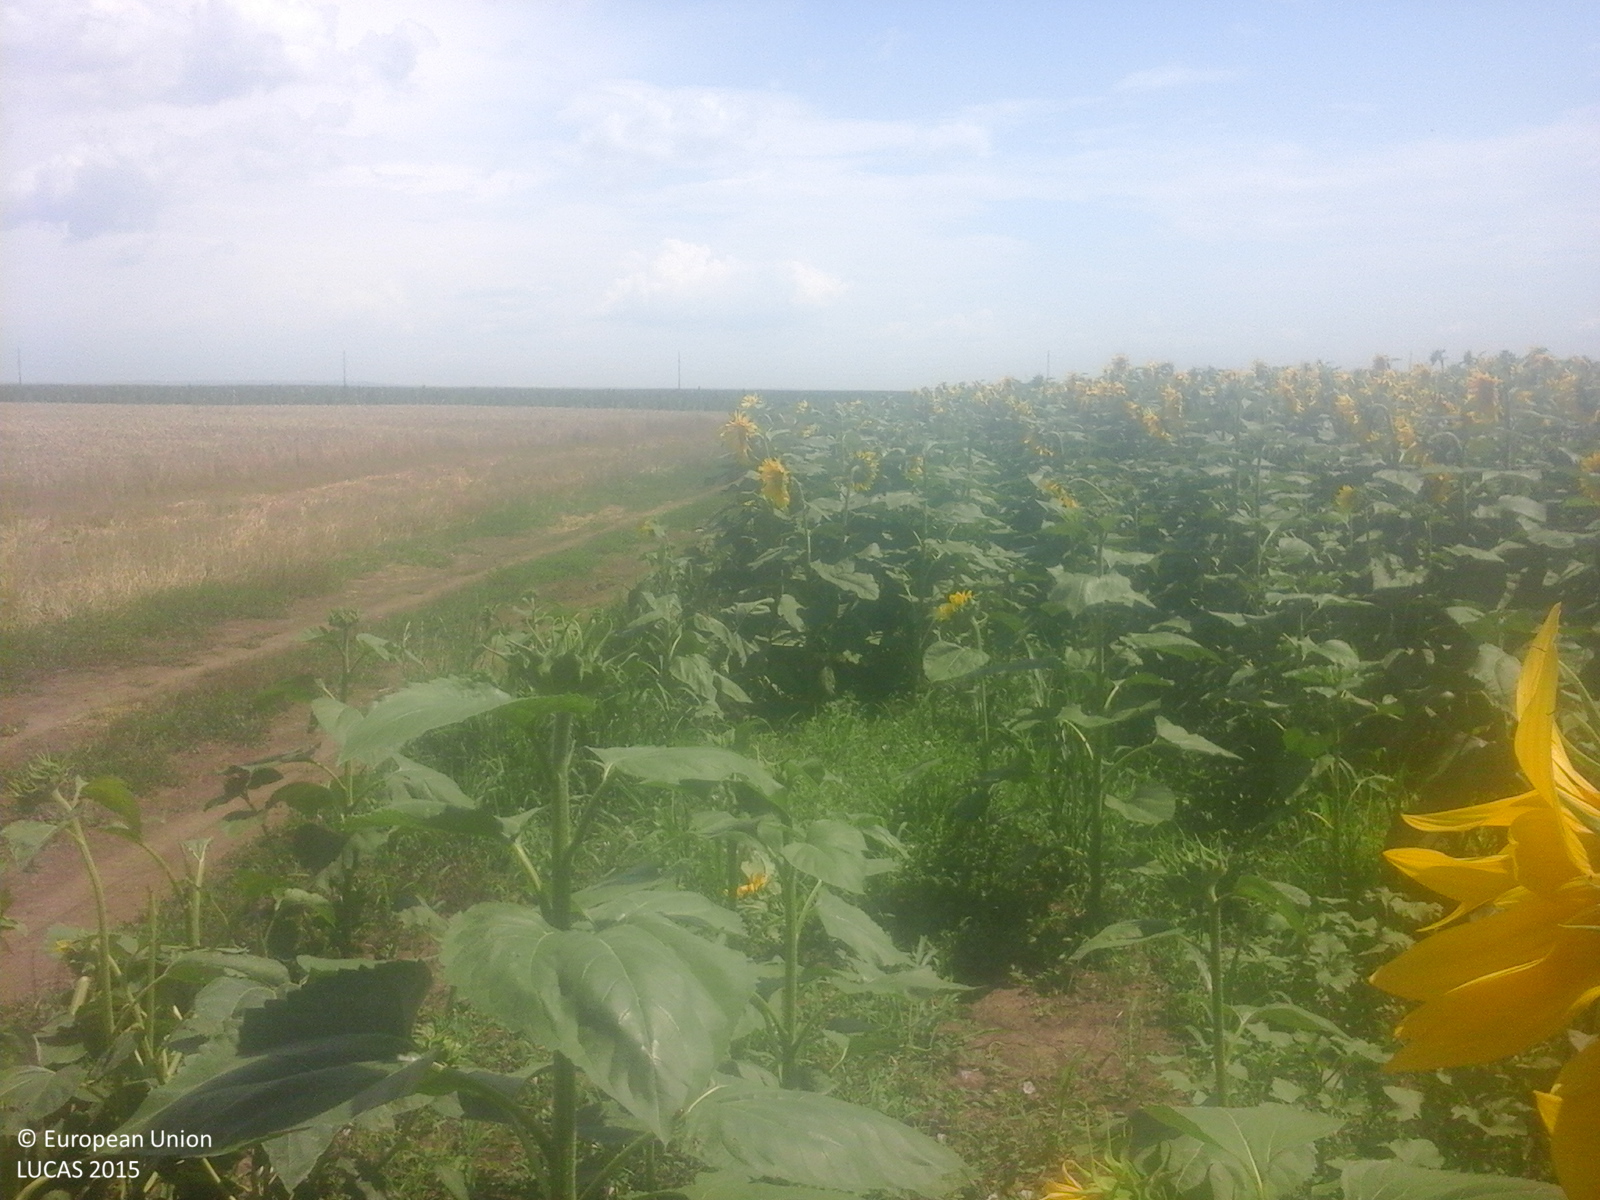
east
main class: Cropland
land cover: Sunflower
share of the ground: > 75 %
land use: Agriculture (excluding fallow land and kitchen gardens)
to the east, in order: Sunflower
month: July
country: RO
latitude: 43.8237
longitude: 24.6022
